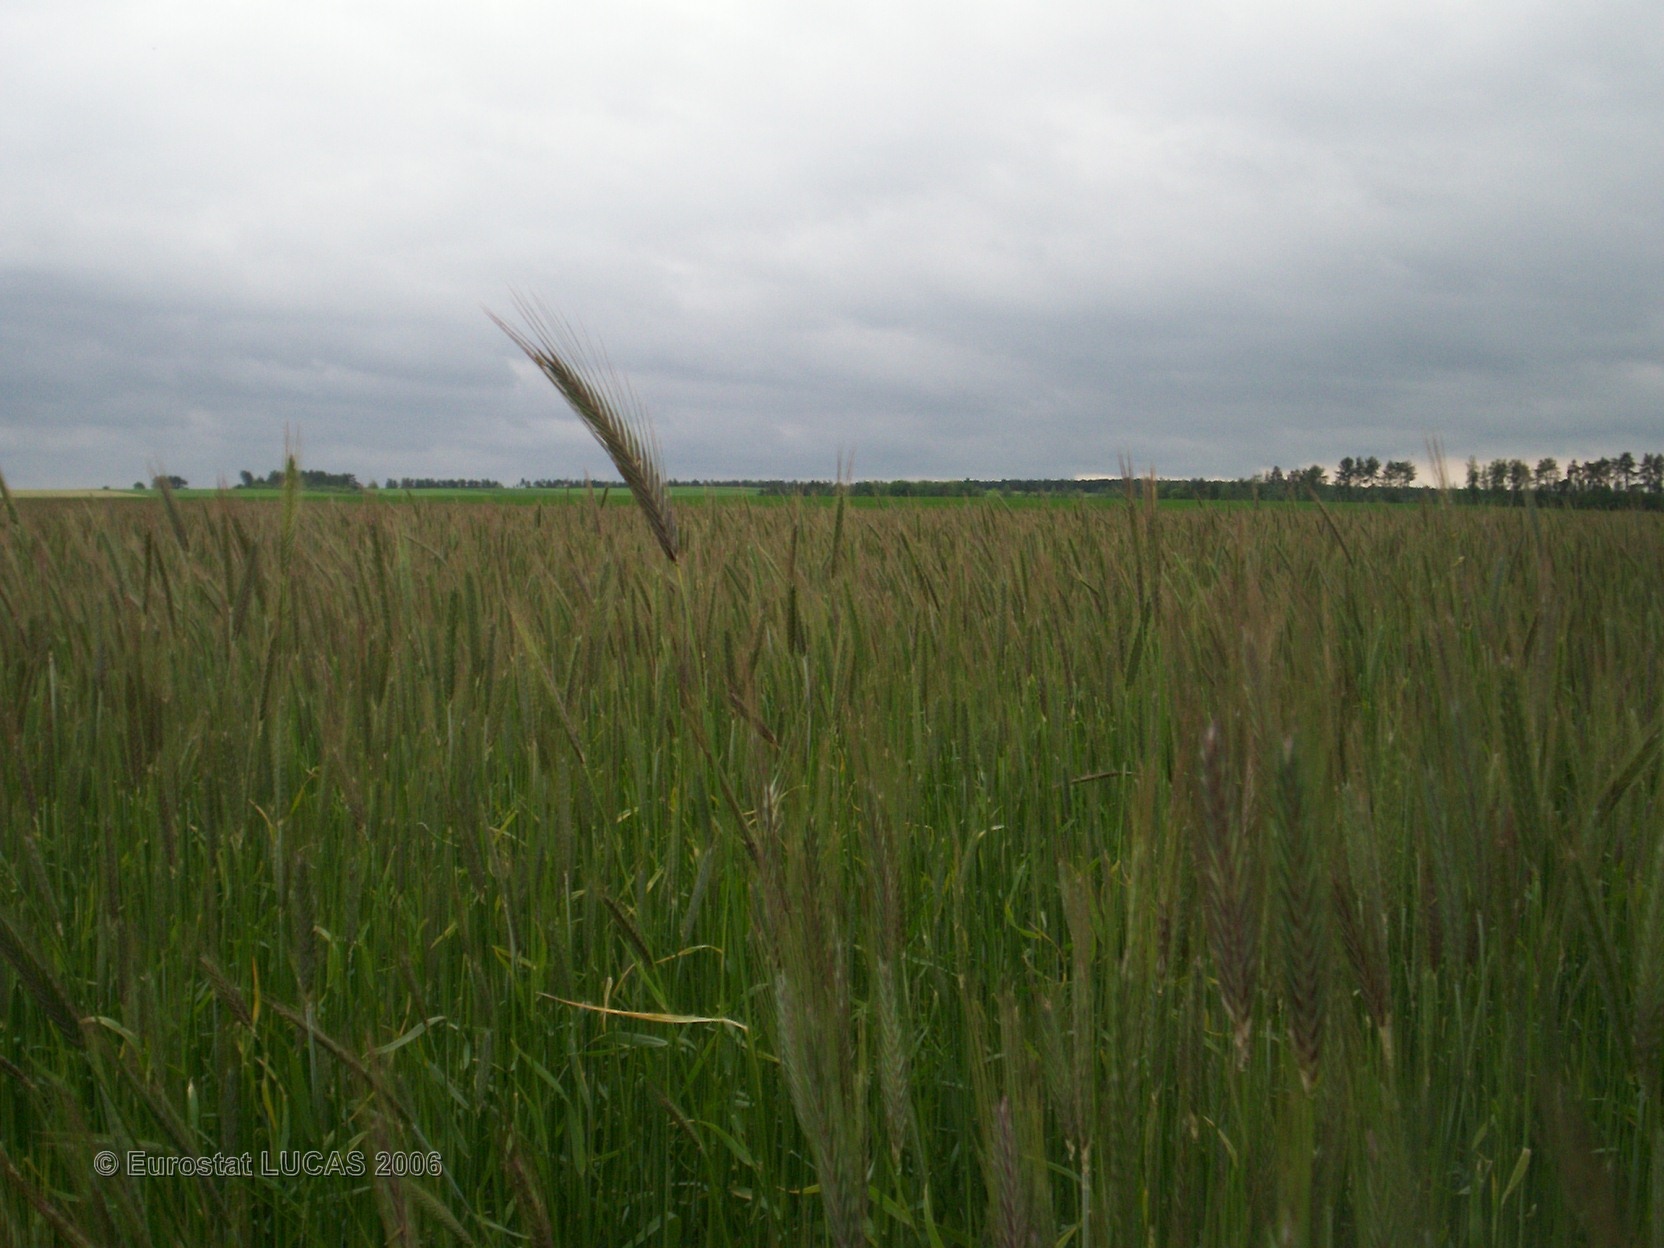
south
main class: Cropland
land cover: Rye
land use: Agriculture (excluding fallow land and kitchen gardens)
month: May
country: FR
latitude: 49.3405
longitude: 4.3392
